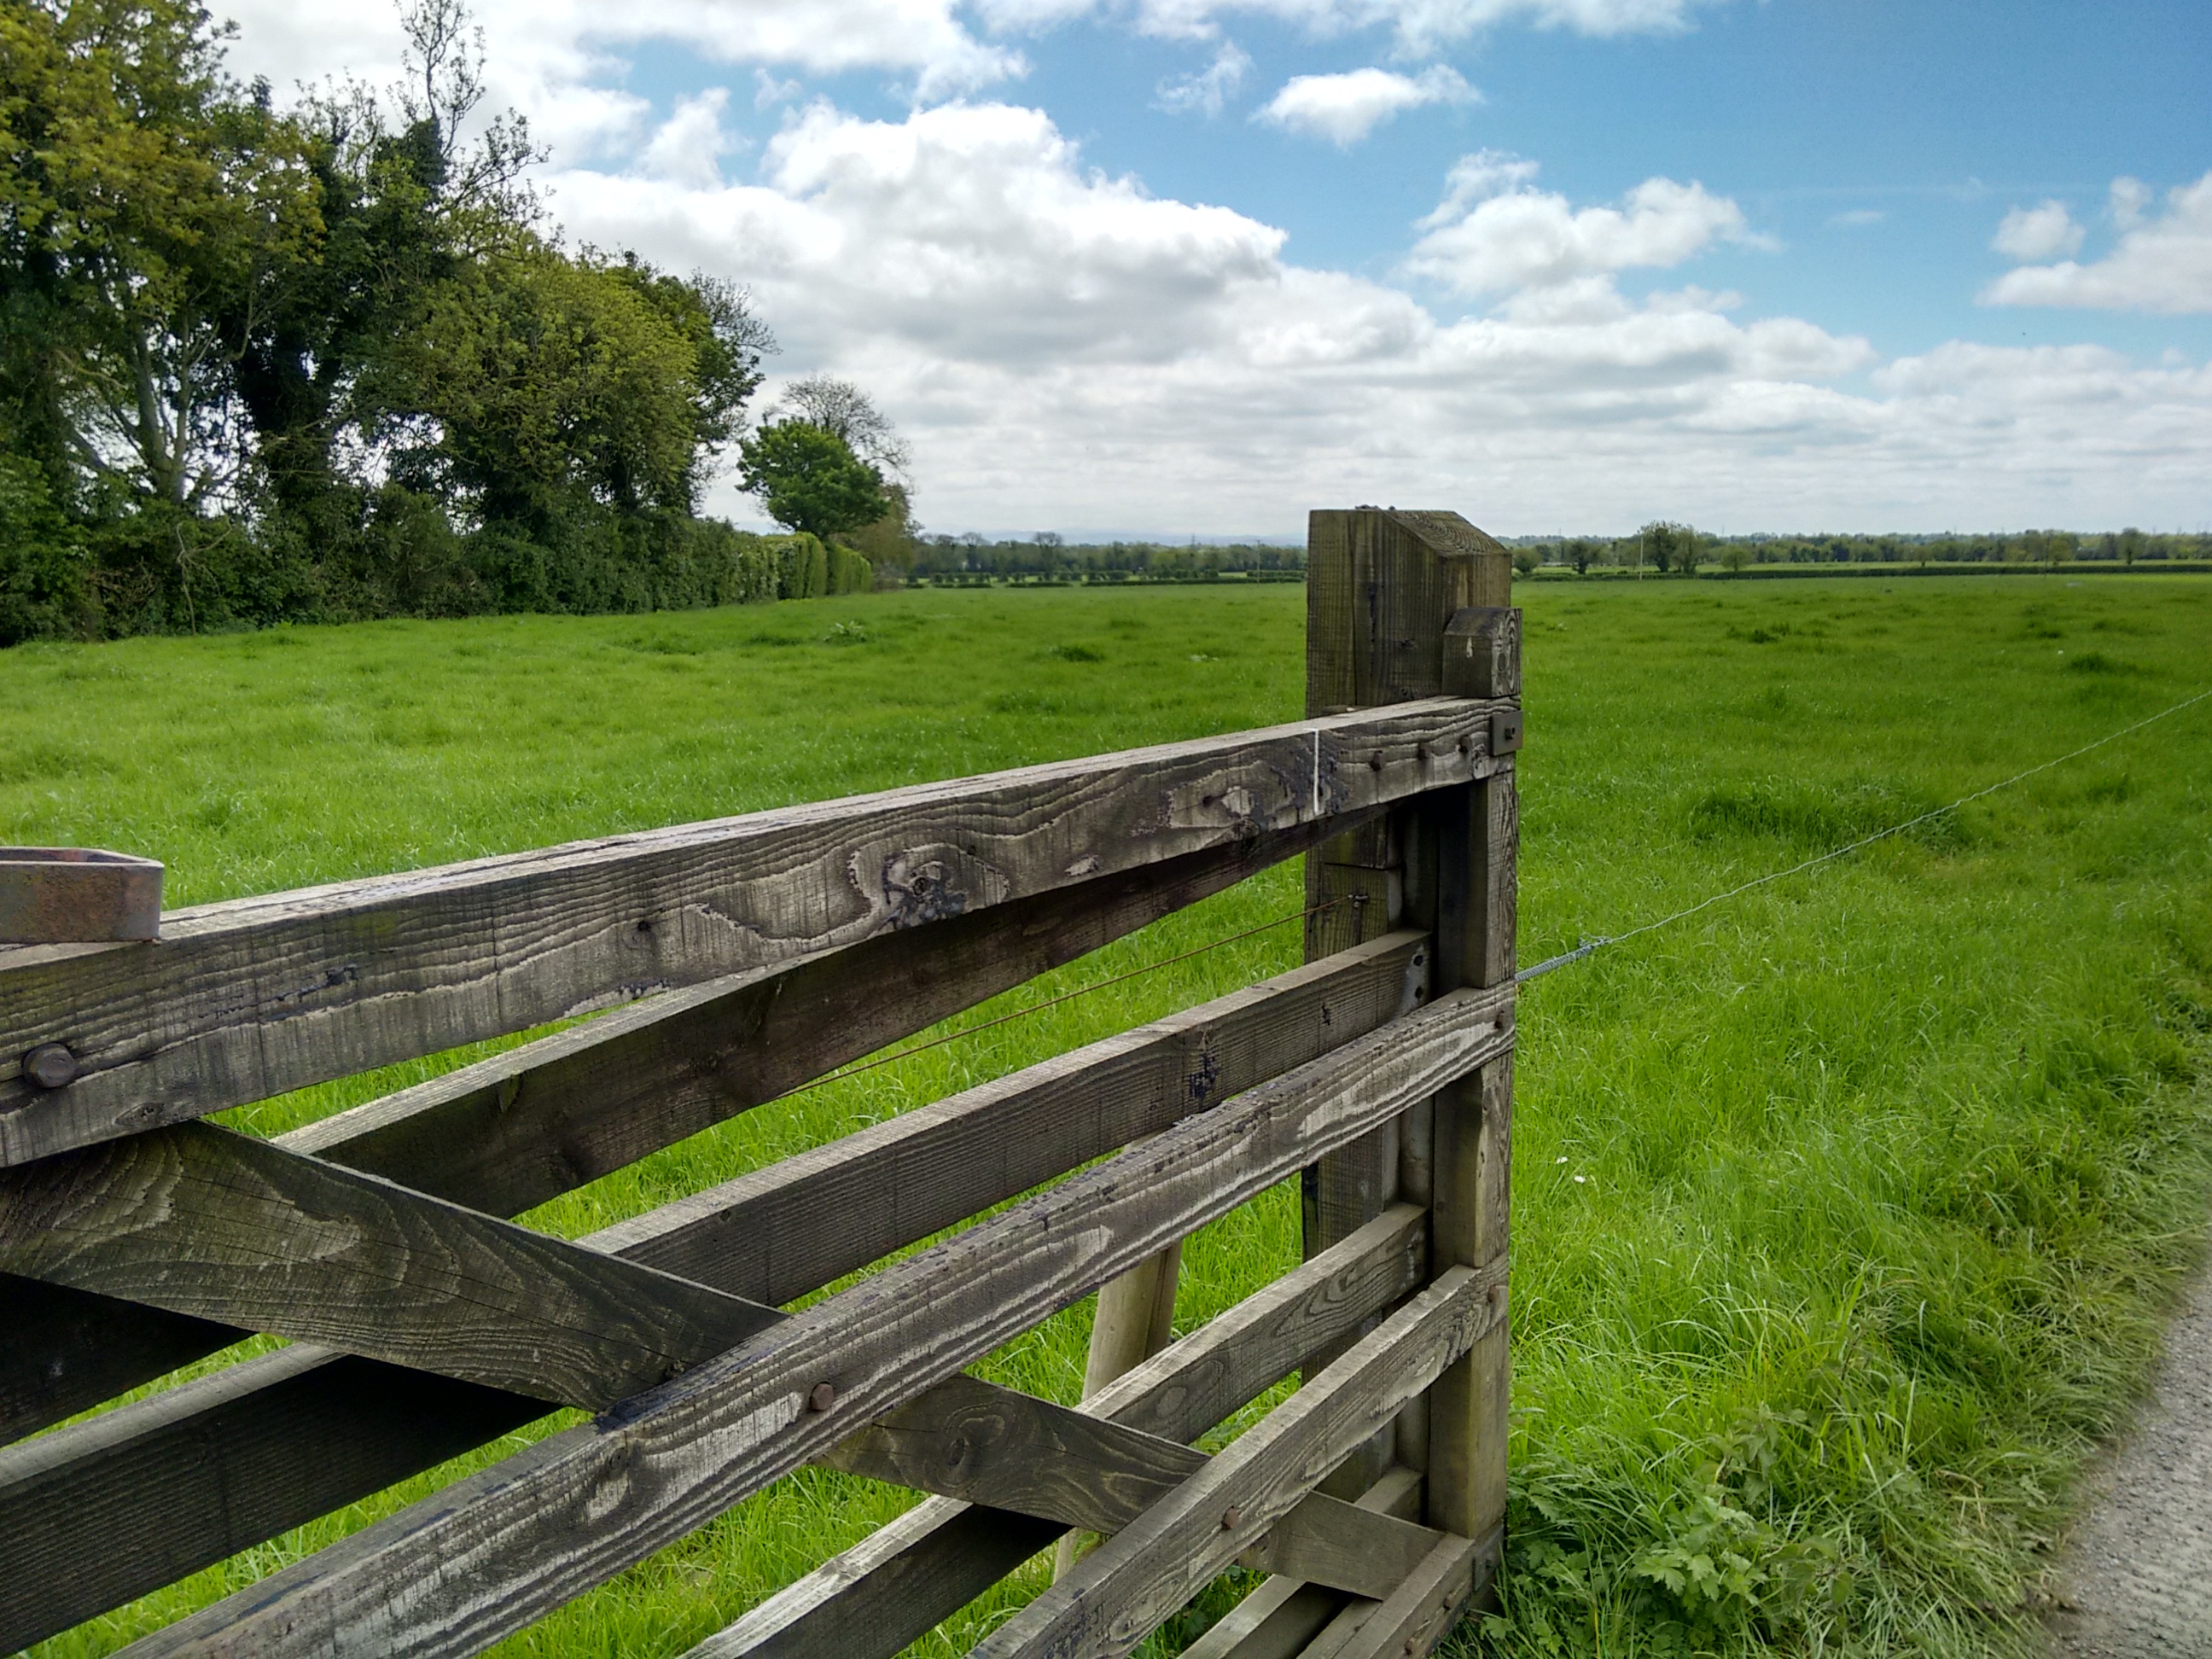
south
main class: Grassland
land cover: Grassland without tree/shrub cover
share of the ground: > 75 %
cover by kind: herbaceous plants 100 %
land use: Agriculture (excluding fallow land and kitchen gardens)
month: May
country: IE
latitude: 53.5019
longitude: -6.5459
